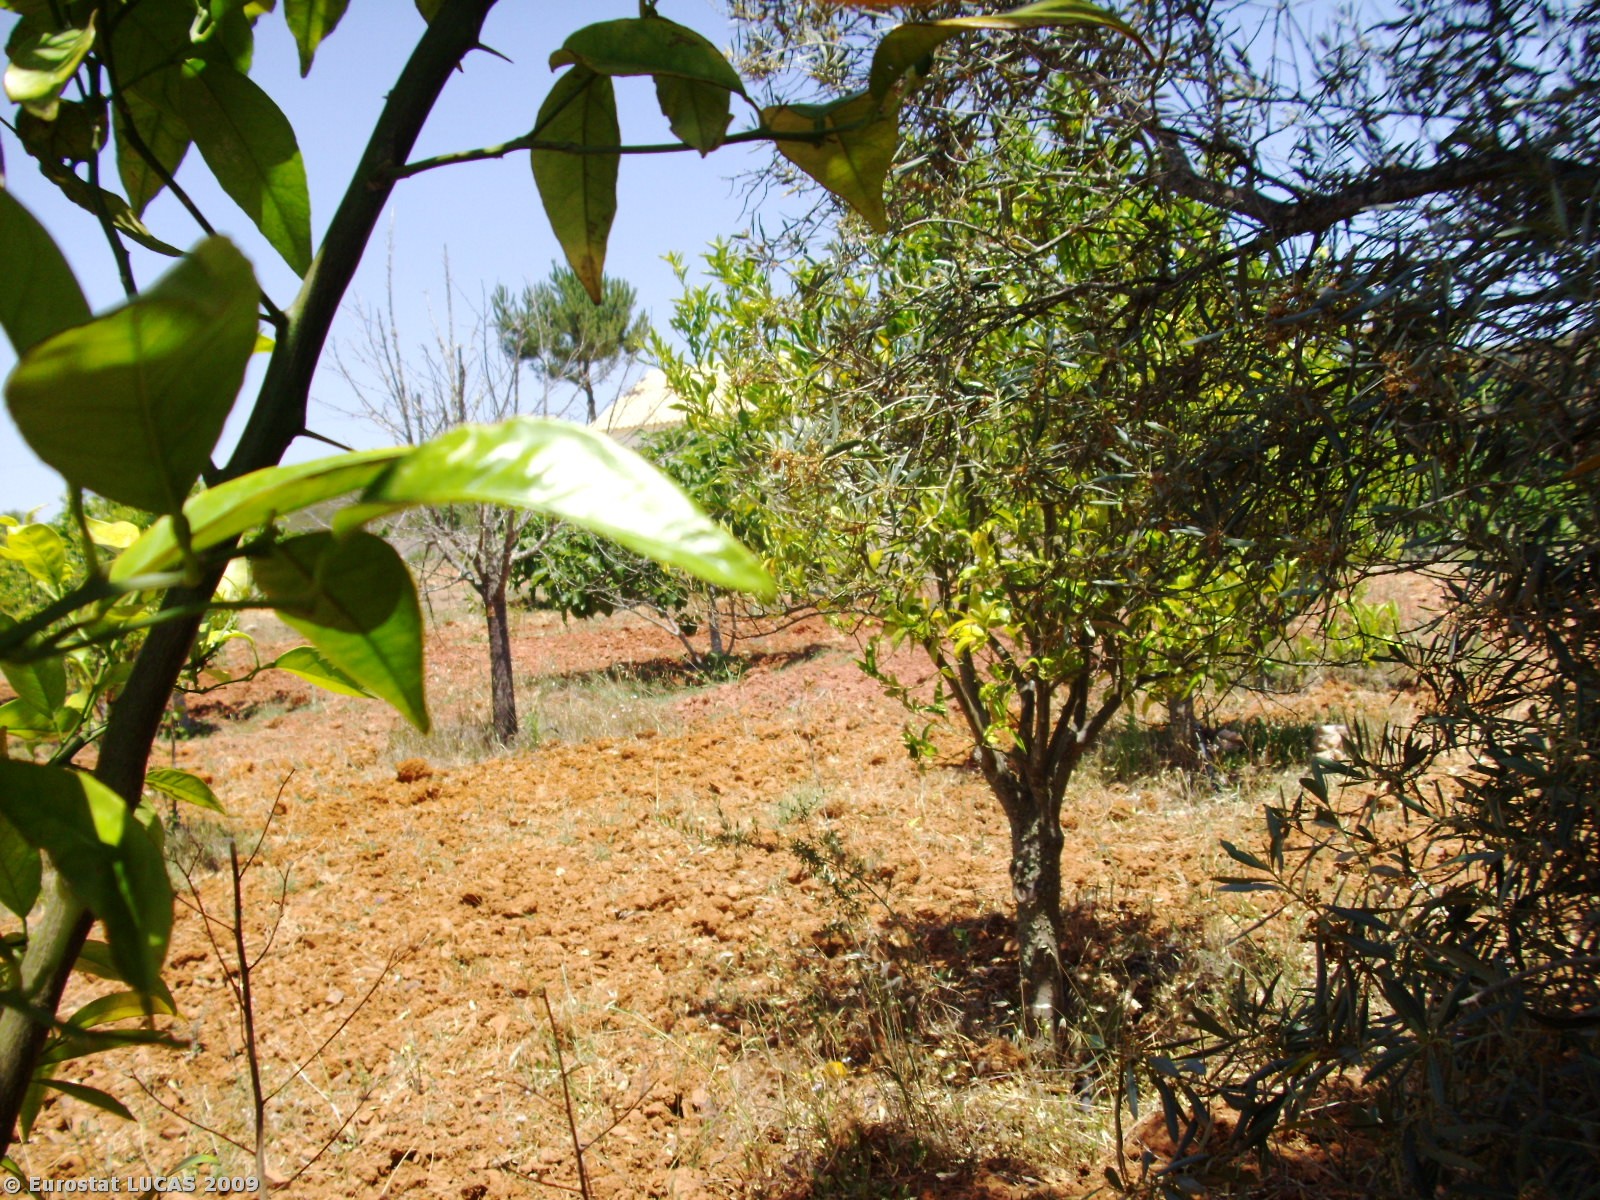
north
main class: Cropland
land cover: Vineyards
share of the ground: 10 - 25 %
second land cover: Oranges
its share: 10 - 25 %
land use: Agriculture (excluding fallow land and kitchen gardens)
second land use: Kitchen garden
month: May
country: PT
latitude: 37.2703
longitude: -8.3028
